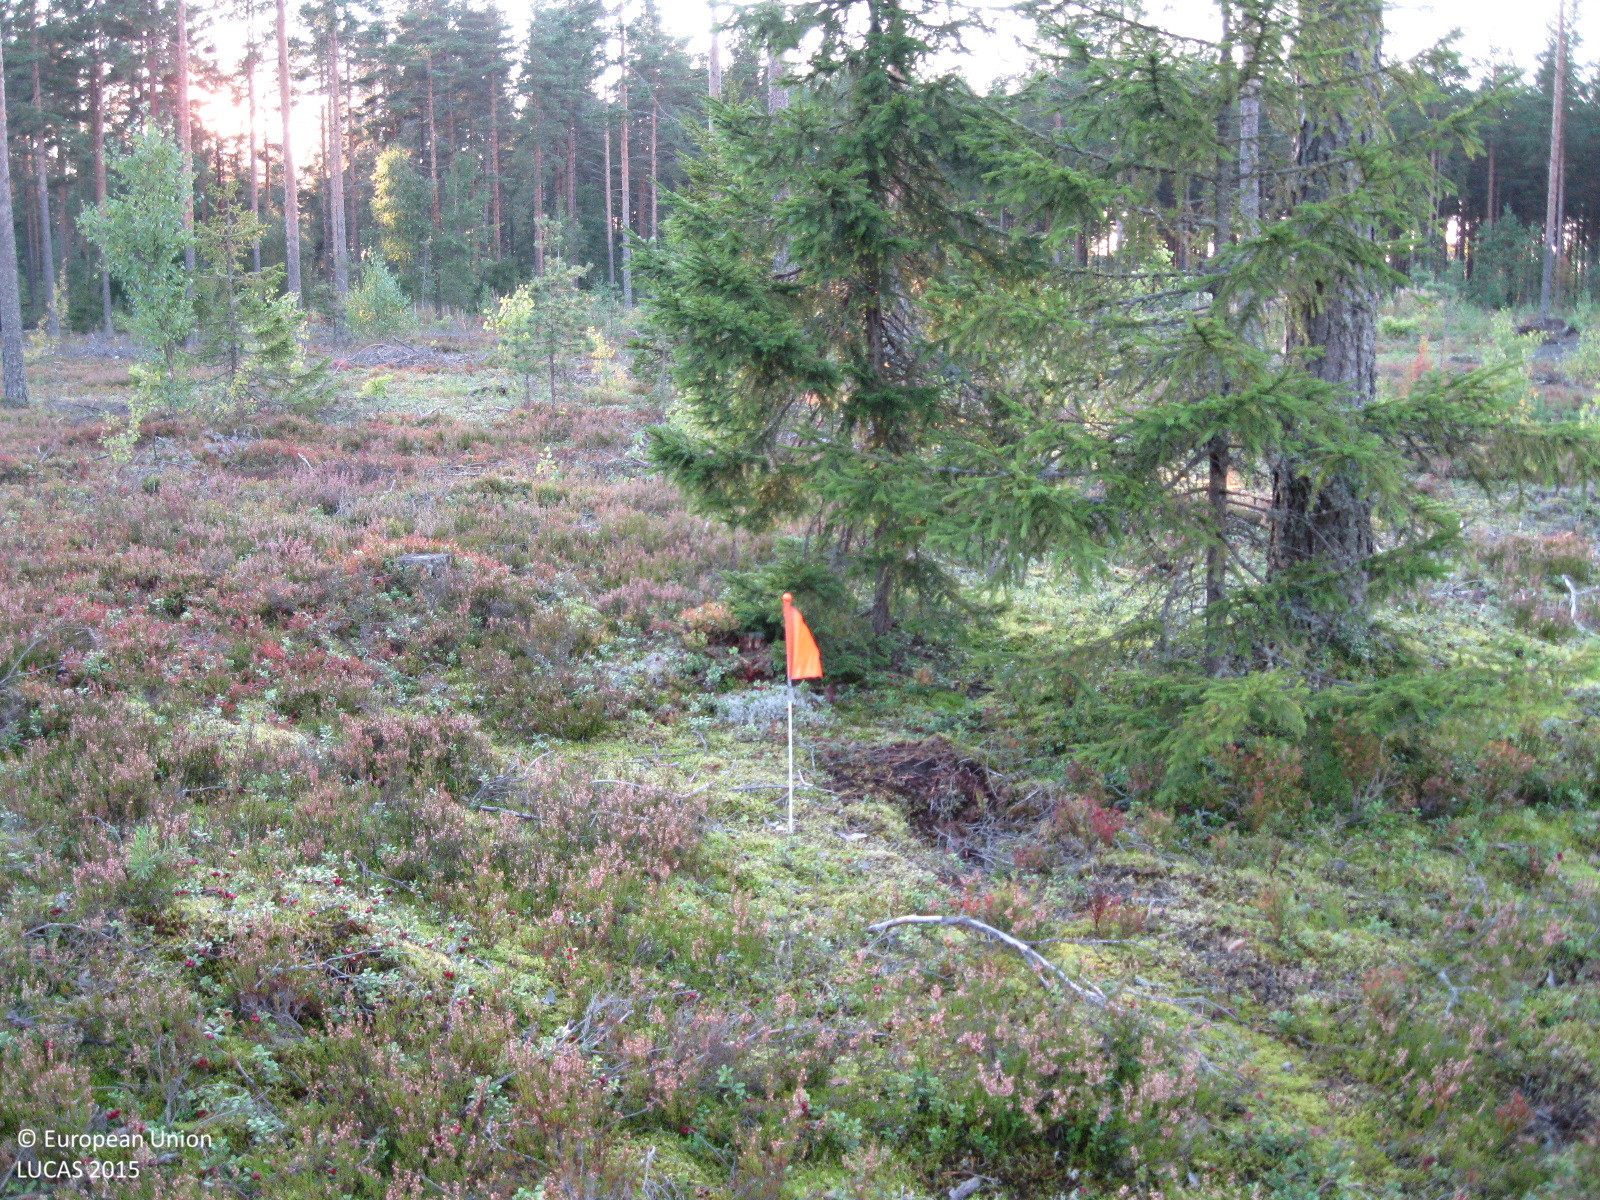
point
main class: Woodland
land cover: Pine dominated coniferous woodland
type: boreal forest
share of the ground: 25 - 50 %
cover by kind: shrubs 45 %, coniferous forest trees 25 %, lichens and mosses 25 %, broadleaved forest trees 5 %
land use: Forestry
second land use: Amenities, museums, leisure
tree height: > 5 m
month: September
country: FI
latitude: 60.5066
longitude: 24.6961
